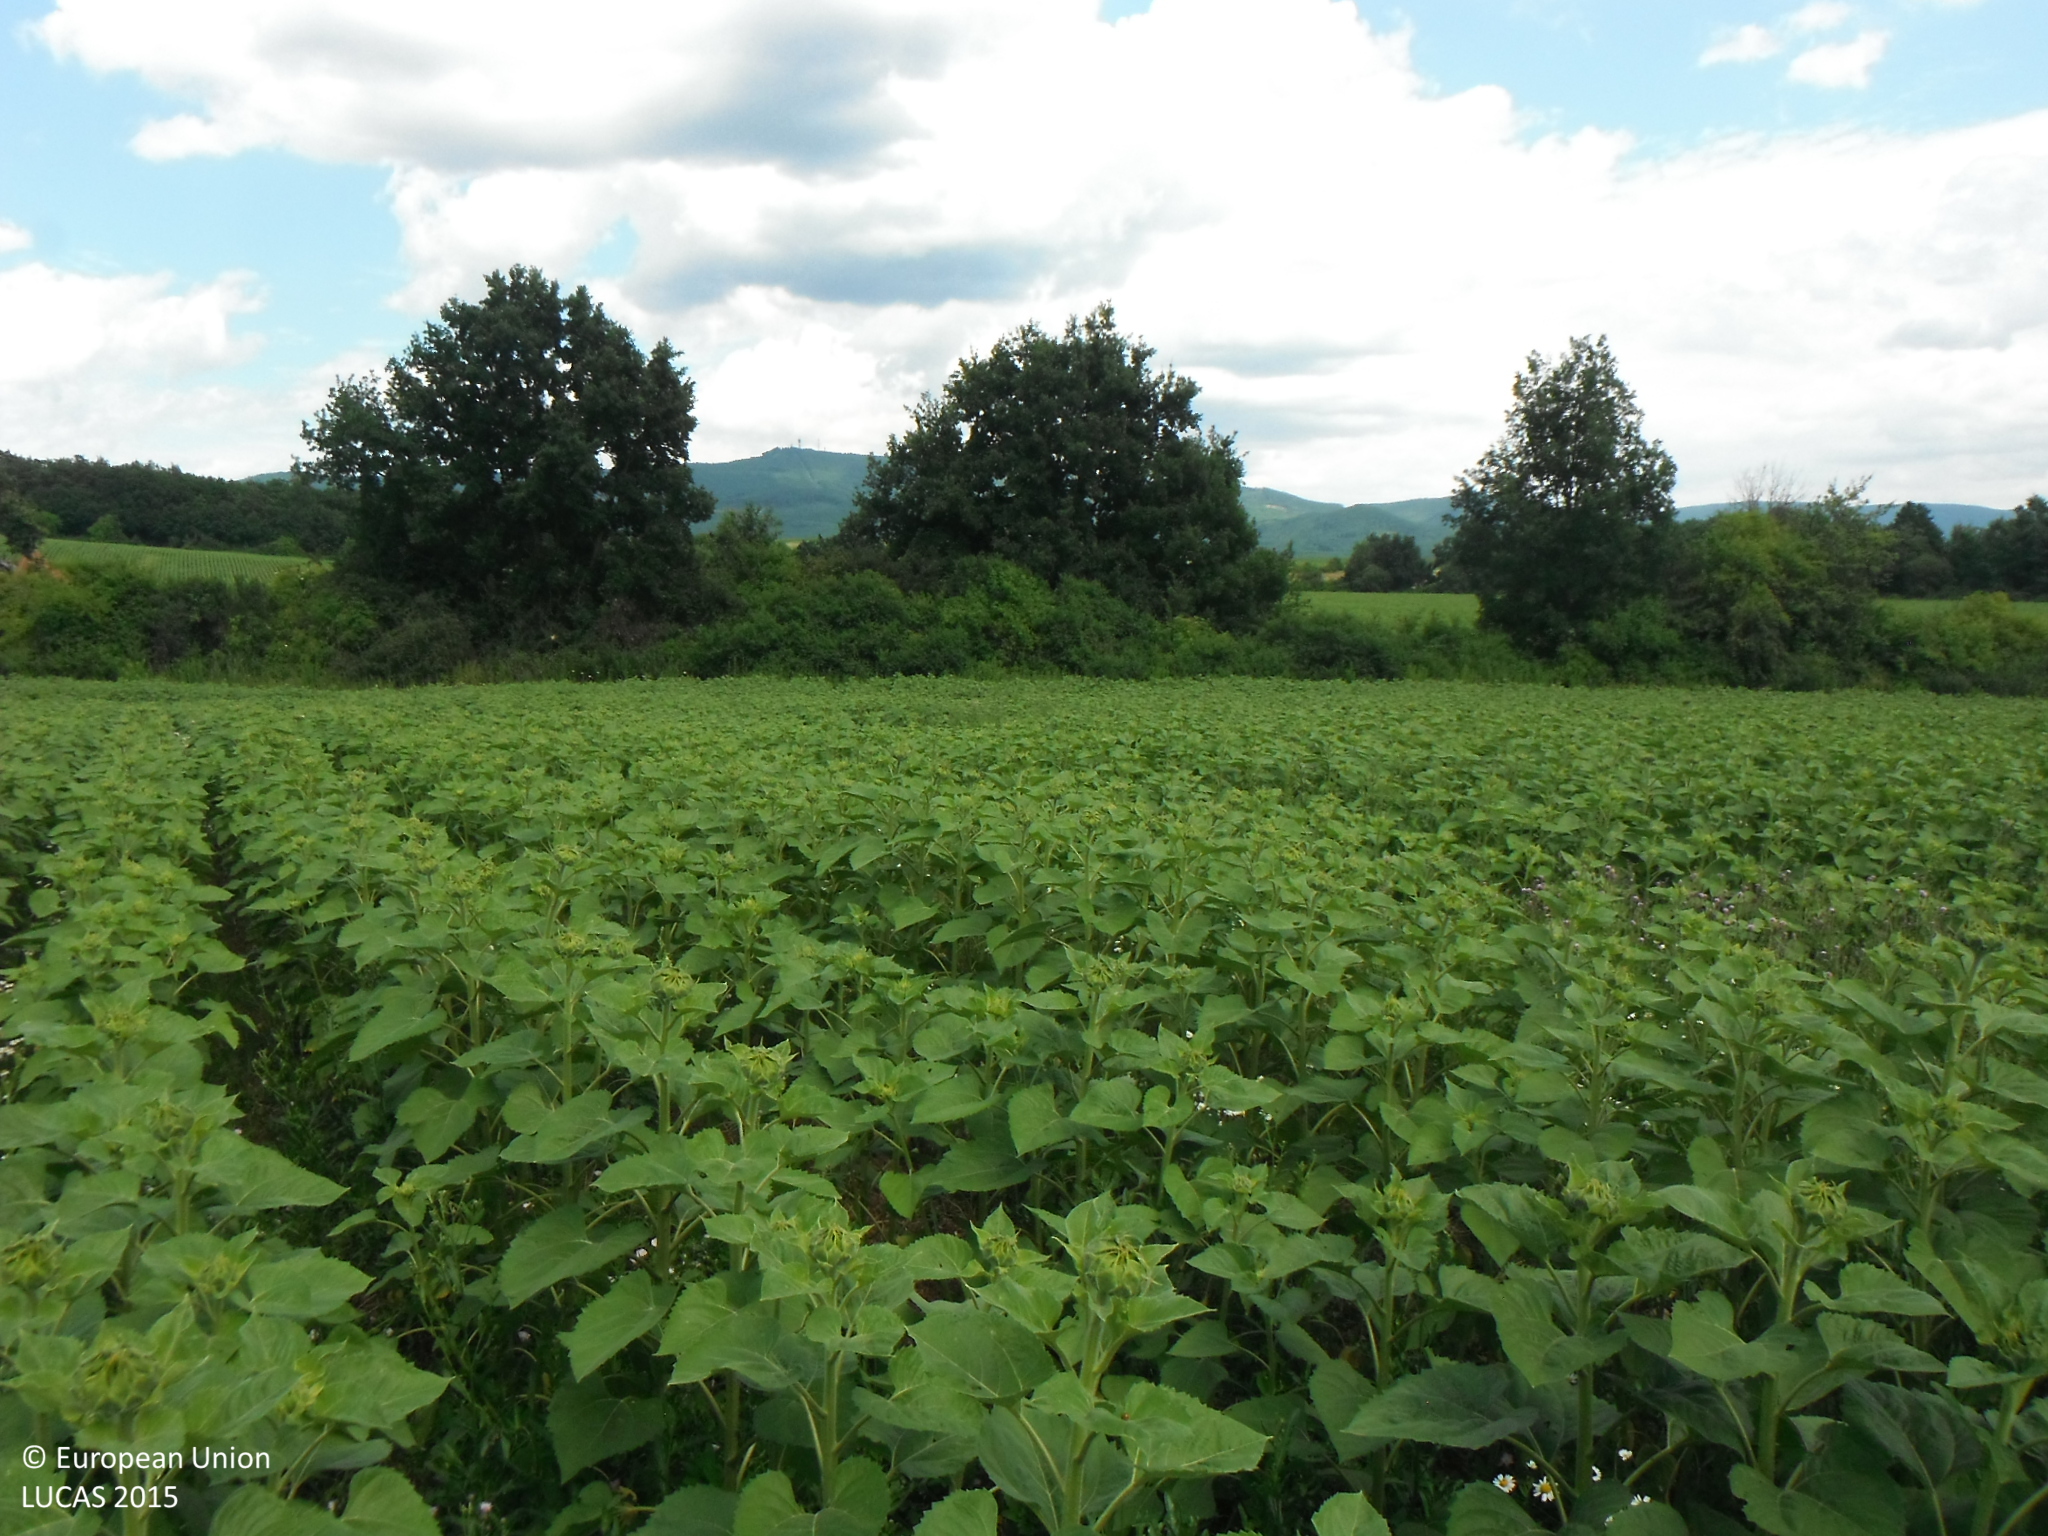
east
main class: Cropland
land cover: Sunflower
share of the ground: > 75 %
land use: Agriculture (excluding fallow land and kitchen gardens)
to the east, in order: Sunflower; Shrubland with sparse tree cover; Sunflower
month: July
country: SK
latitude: 48.8476
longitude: 21.3982
